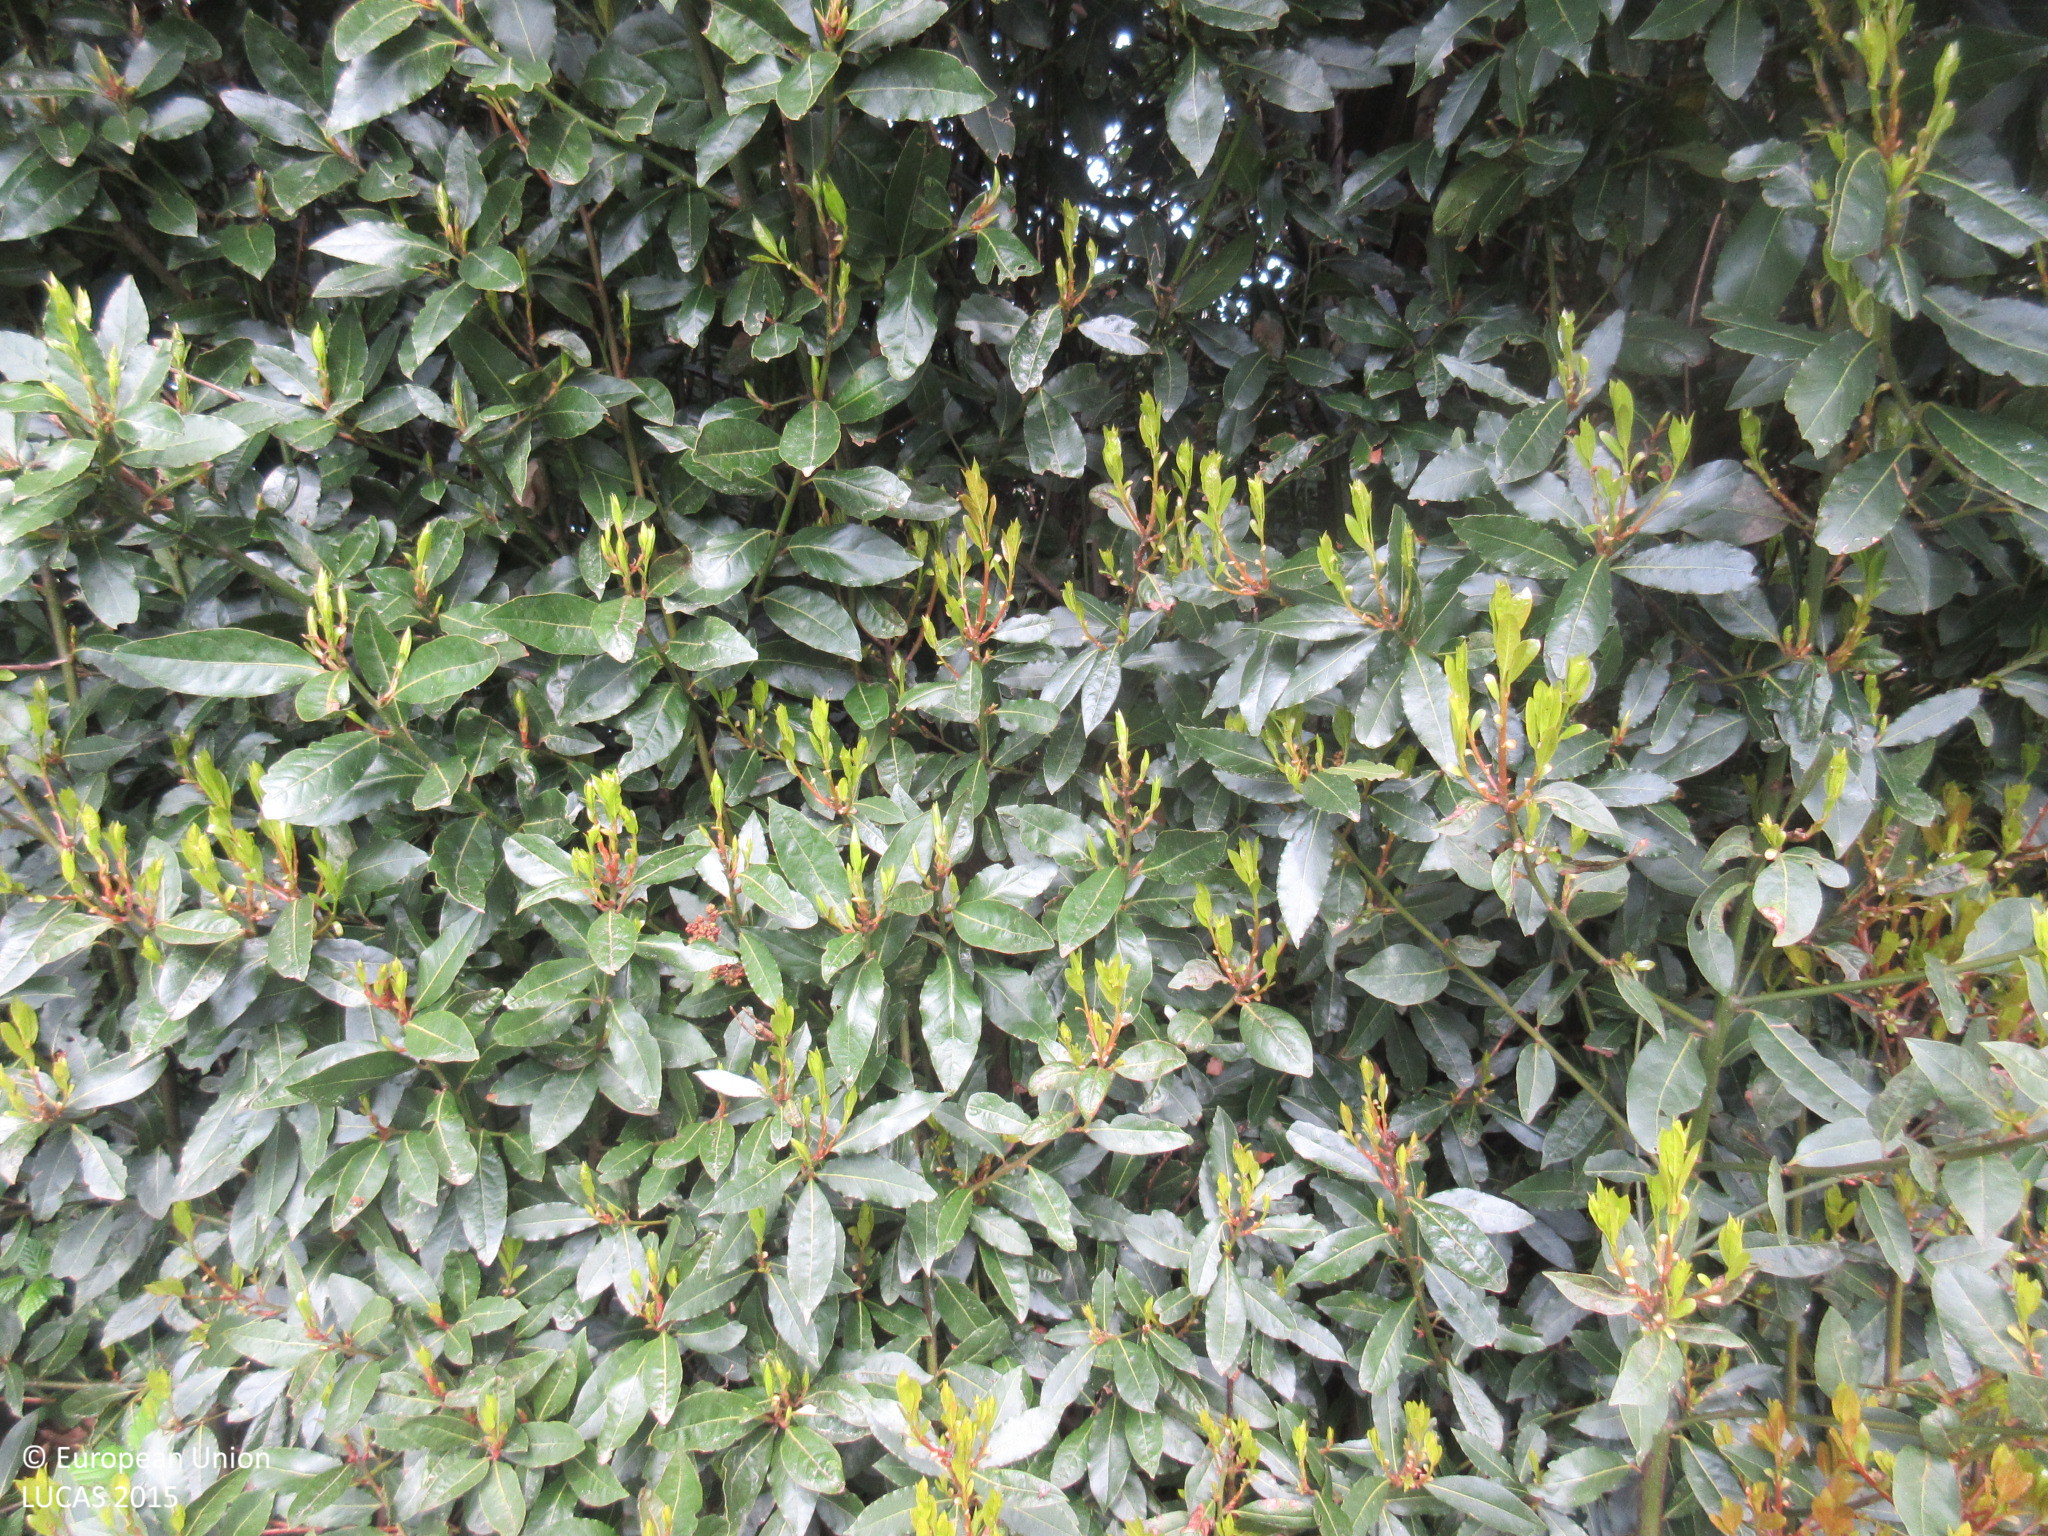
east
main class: Grassland
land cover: Grassland without tree/shrub cover
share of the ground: > 75 %
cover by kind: herbaceous plants 100 %
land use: Agriculture (excluding fallow land and kitchen gardens)
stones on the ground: 10 - 25 %
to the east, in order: Grassland without tree/shrub cover; Groves; Fences; Electric lines; Other structural elements; Broadleaved woodland
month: April
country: ES
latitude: 43.4923
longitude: -6.4130
